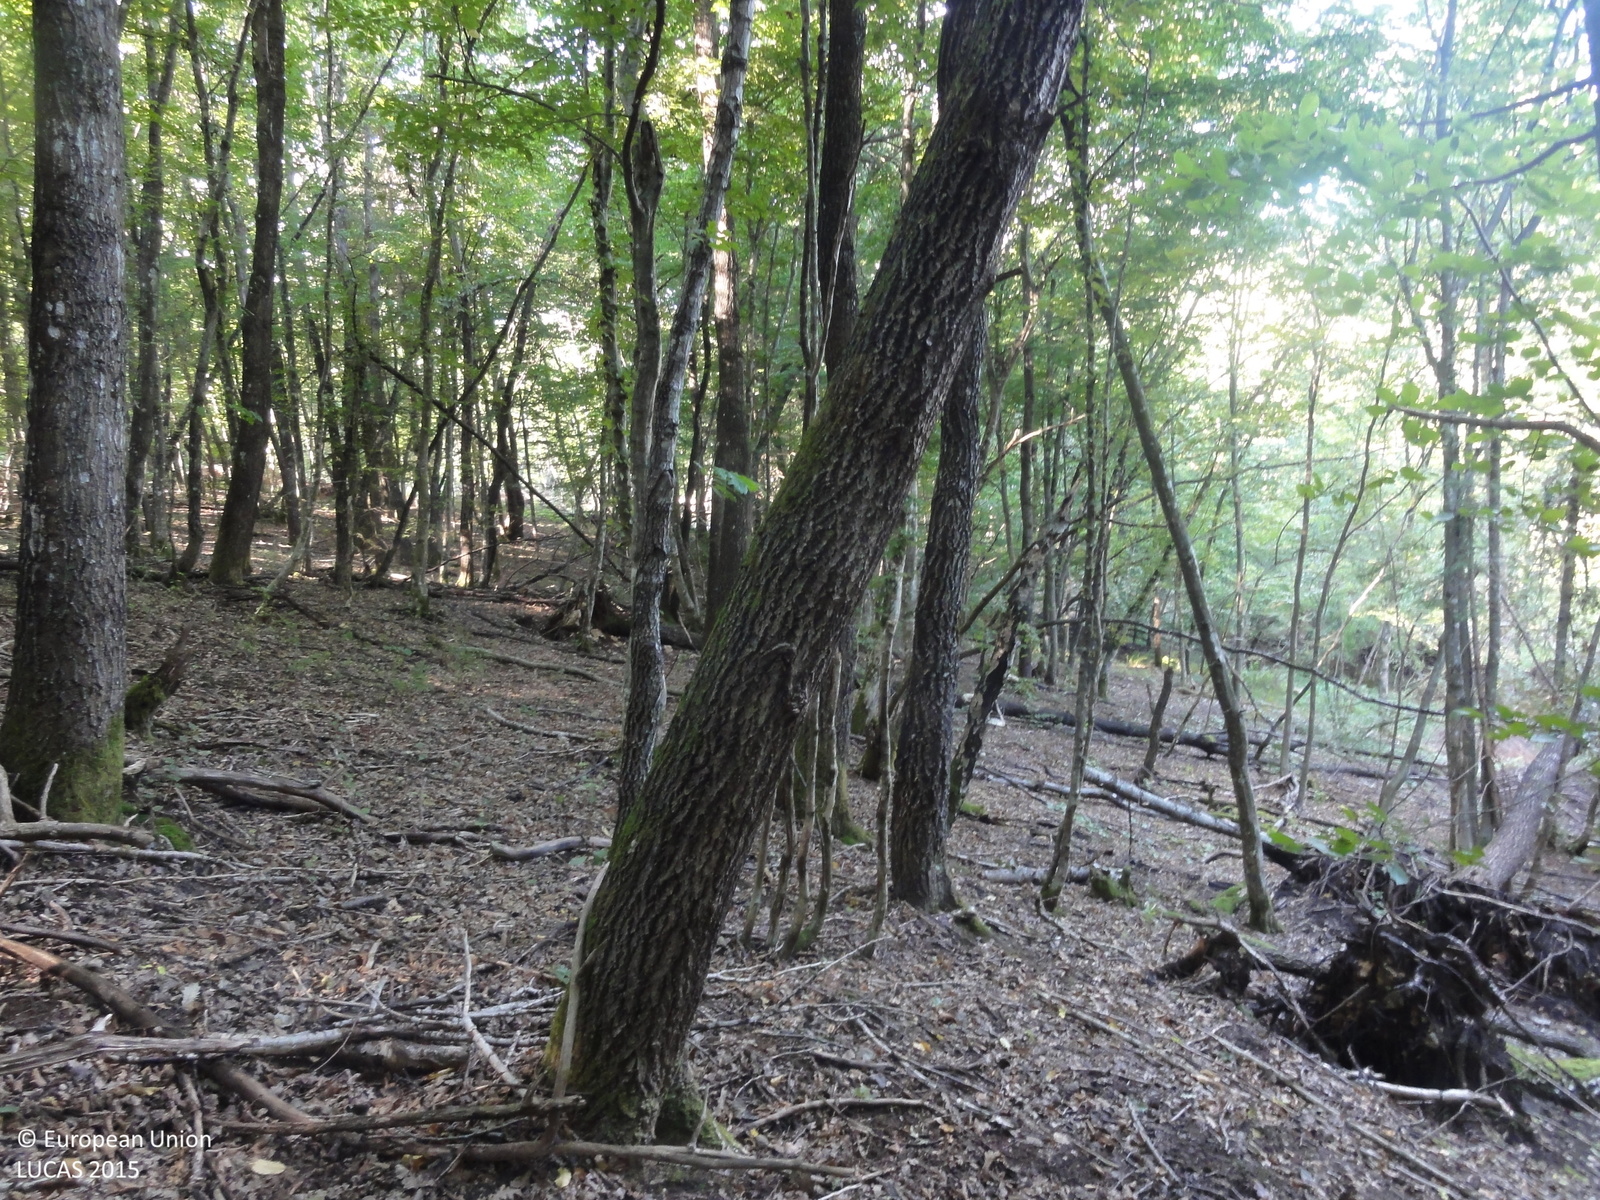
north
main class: Woodland
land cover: Broadleaved woodland
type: mesophytic deciduous forest
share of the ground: > 75 %
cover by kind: broadleaved forest trees 100 %
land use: Forestry
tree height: > 5 m
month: September
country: SI
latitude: 45.7194
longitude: 15.1997
